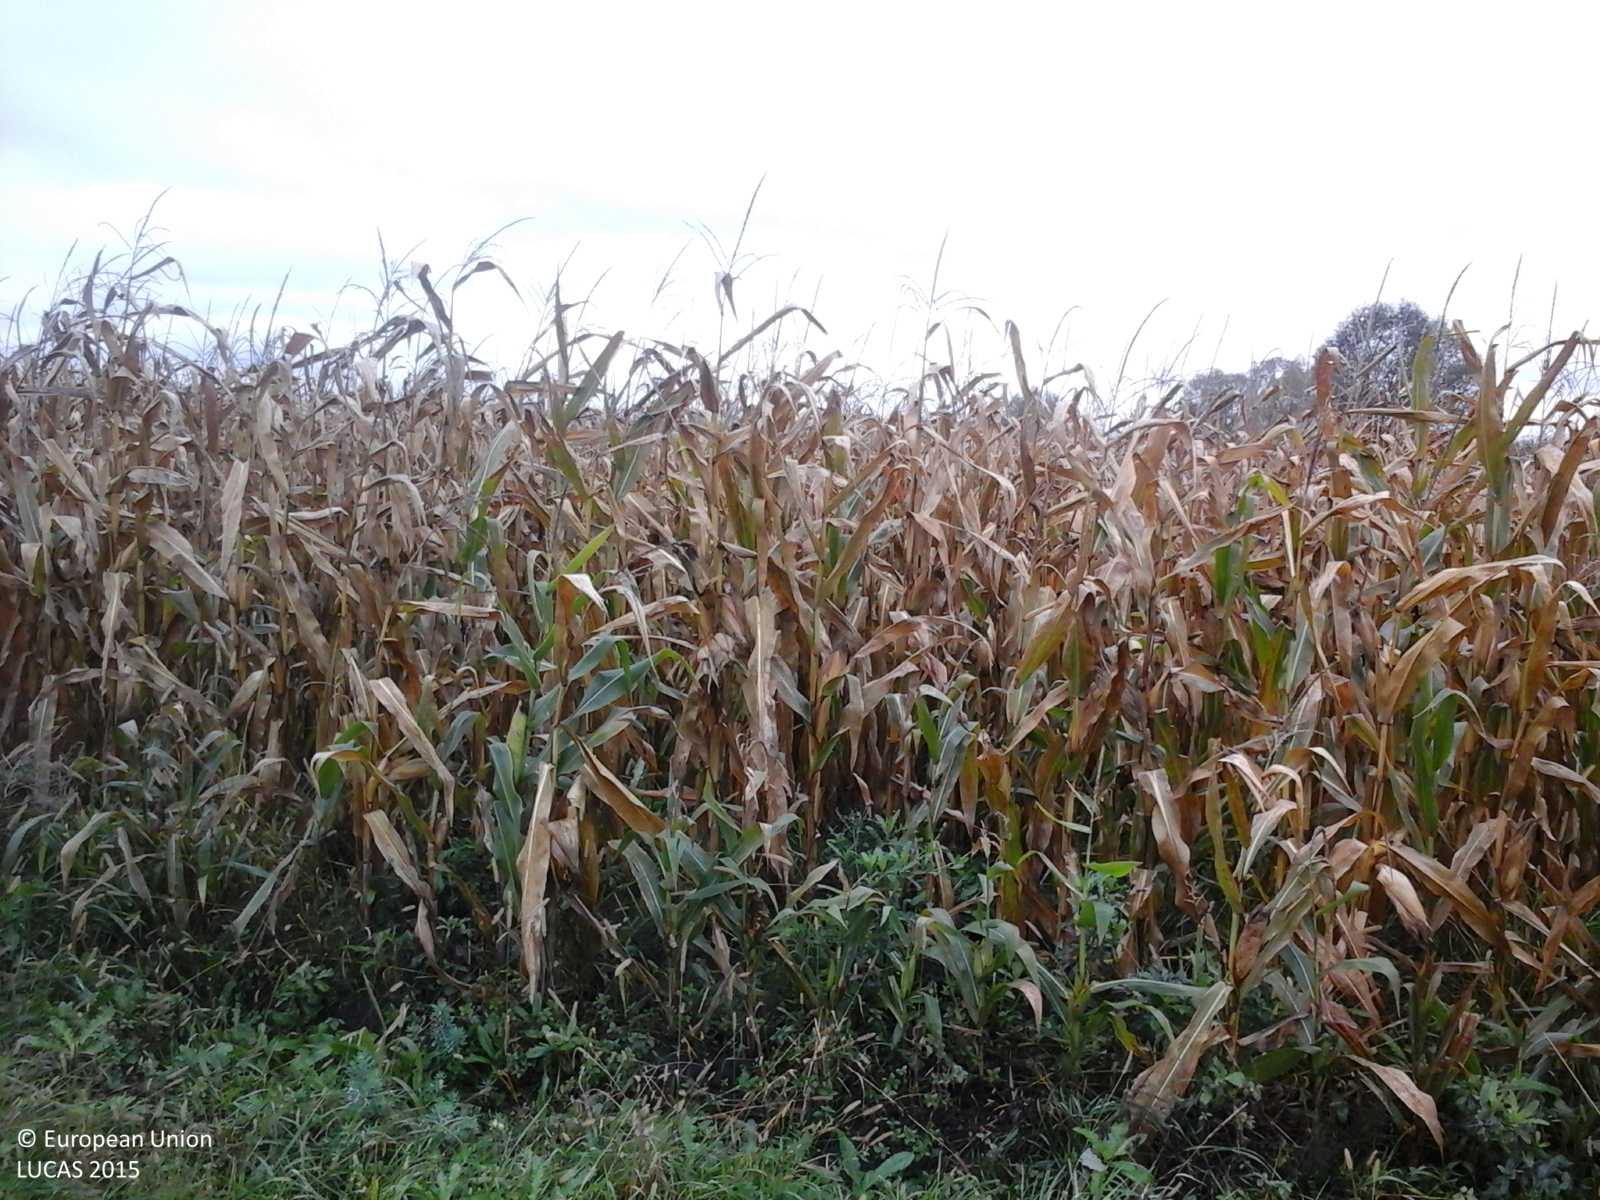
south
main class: Cropland
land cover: Maize
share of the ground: > 75 %
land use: Agriculture (excluding fallow land and kitchen gardens)
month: October
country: RO
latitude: 45.8293
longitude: 24.1188
